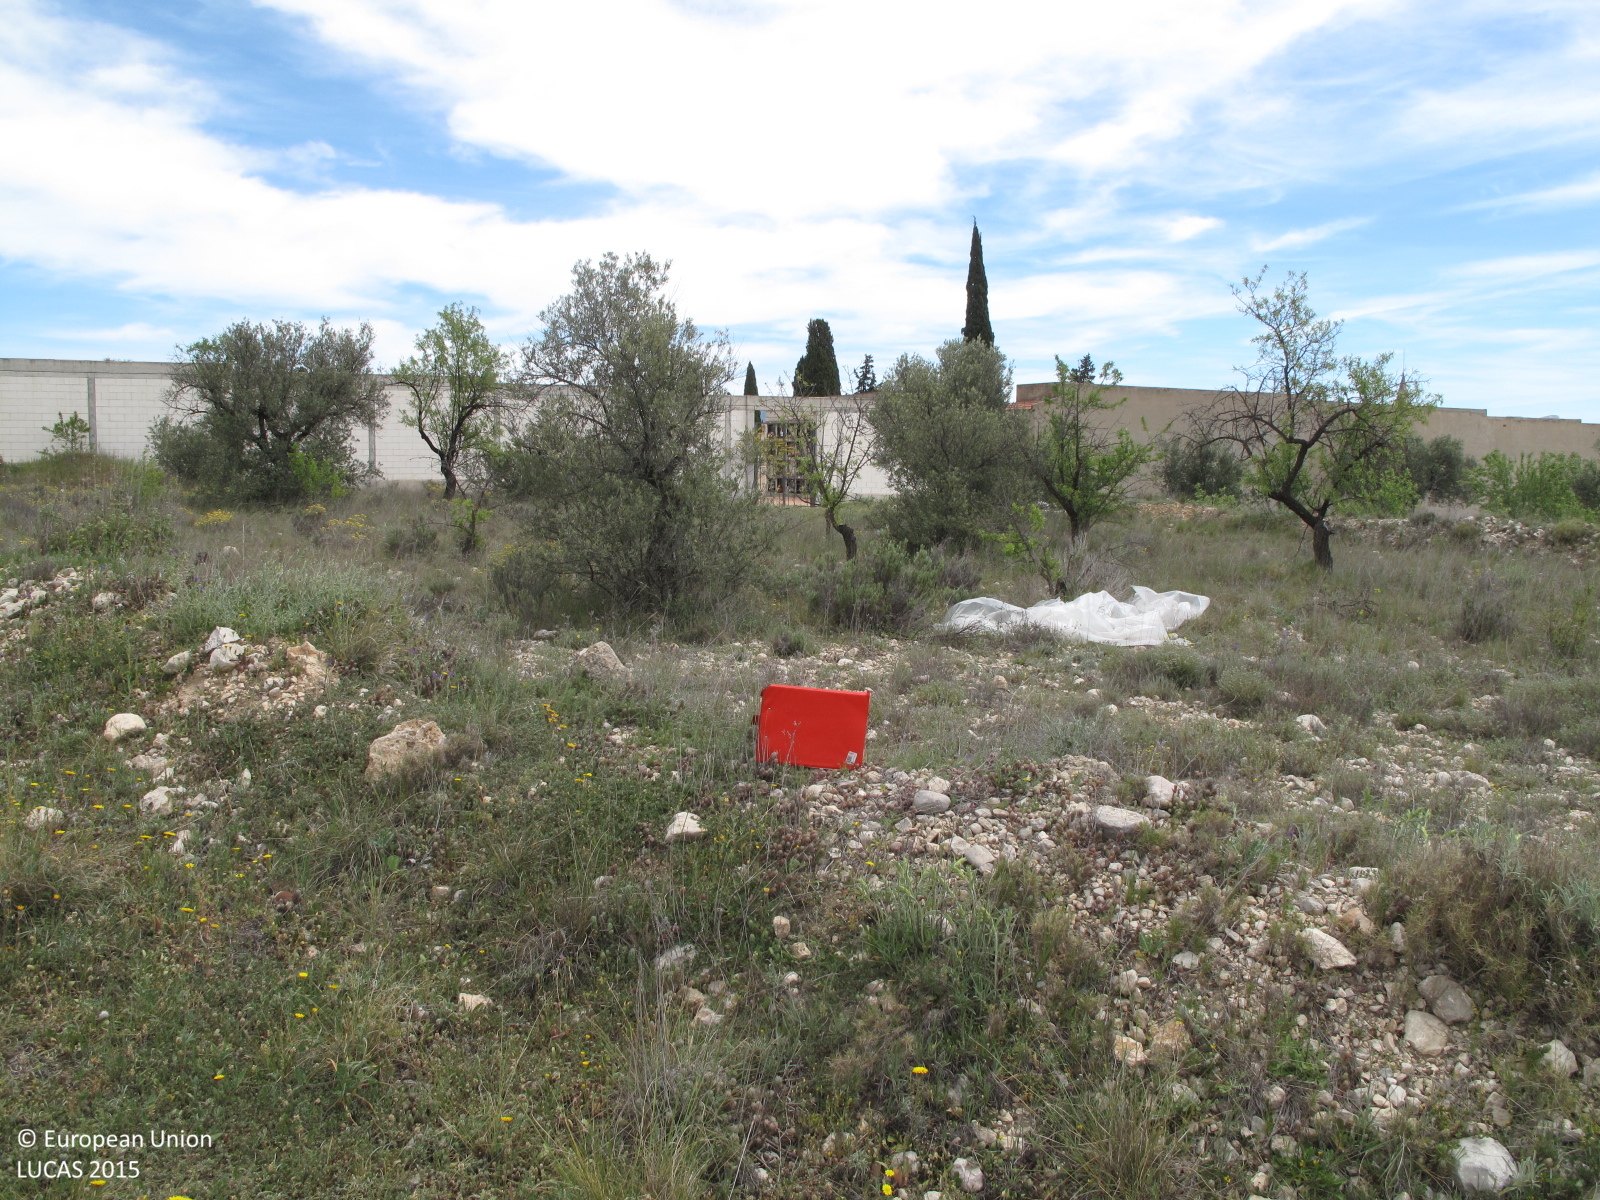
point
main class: Cropland
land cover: Olive groves
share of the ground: < 10 %
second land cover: Nuts trees
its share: < 10 %
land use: Agriculture (excluding fallow land and kitchen gardens)
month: April
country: ES
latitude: 38.6239
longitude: -0.6829
